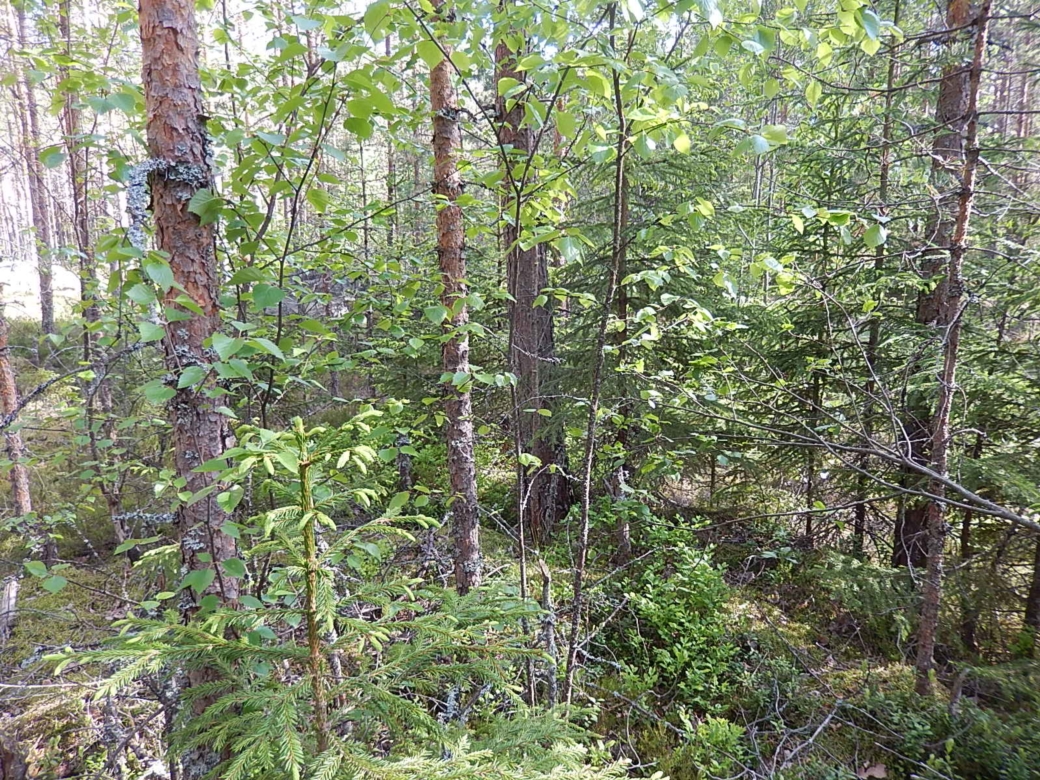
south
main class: Woodland
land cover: Pine dominated coniferous woodland
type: boreal forest
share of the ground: > 75 %
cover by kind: coniferous forest trees 75 %, shrubs 15 %, broadleaved forest trees 10 %
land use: Forestry
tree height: > 5 m
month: June
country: FI
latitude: 61.9050
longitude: 22.2968
